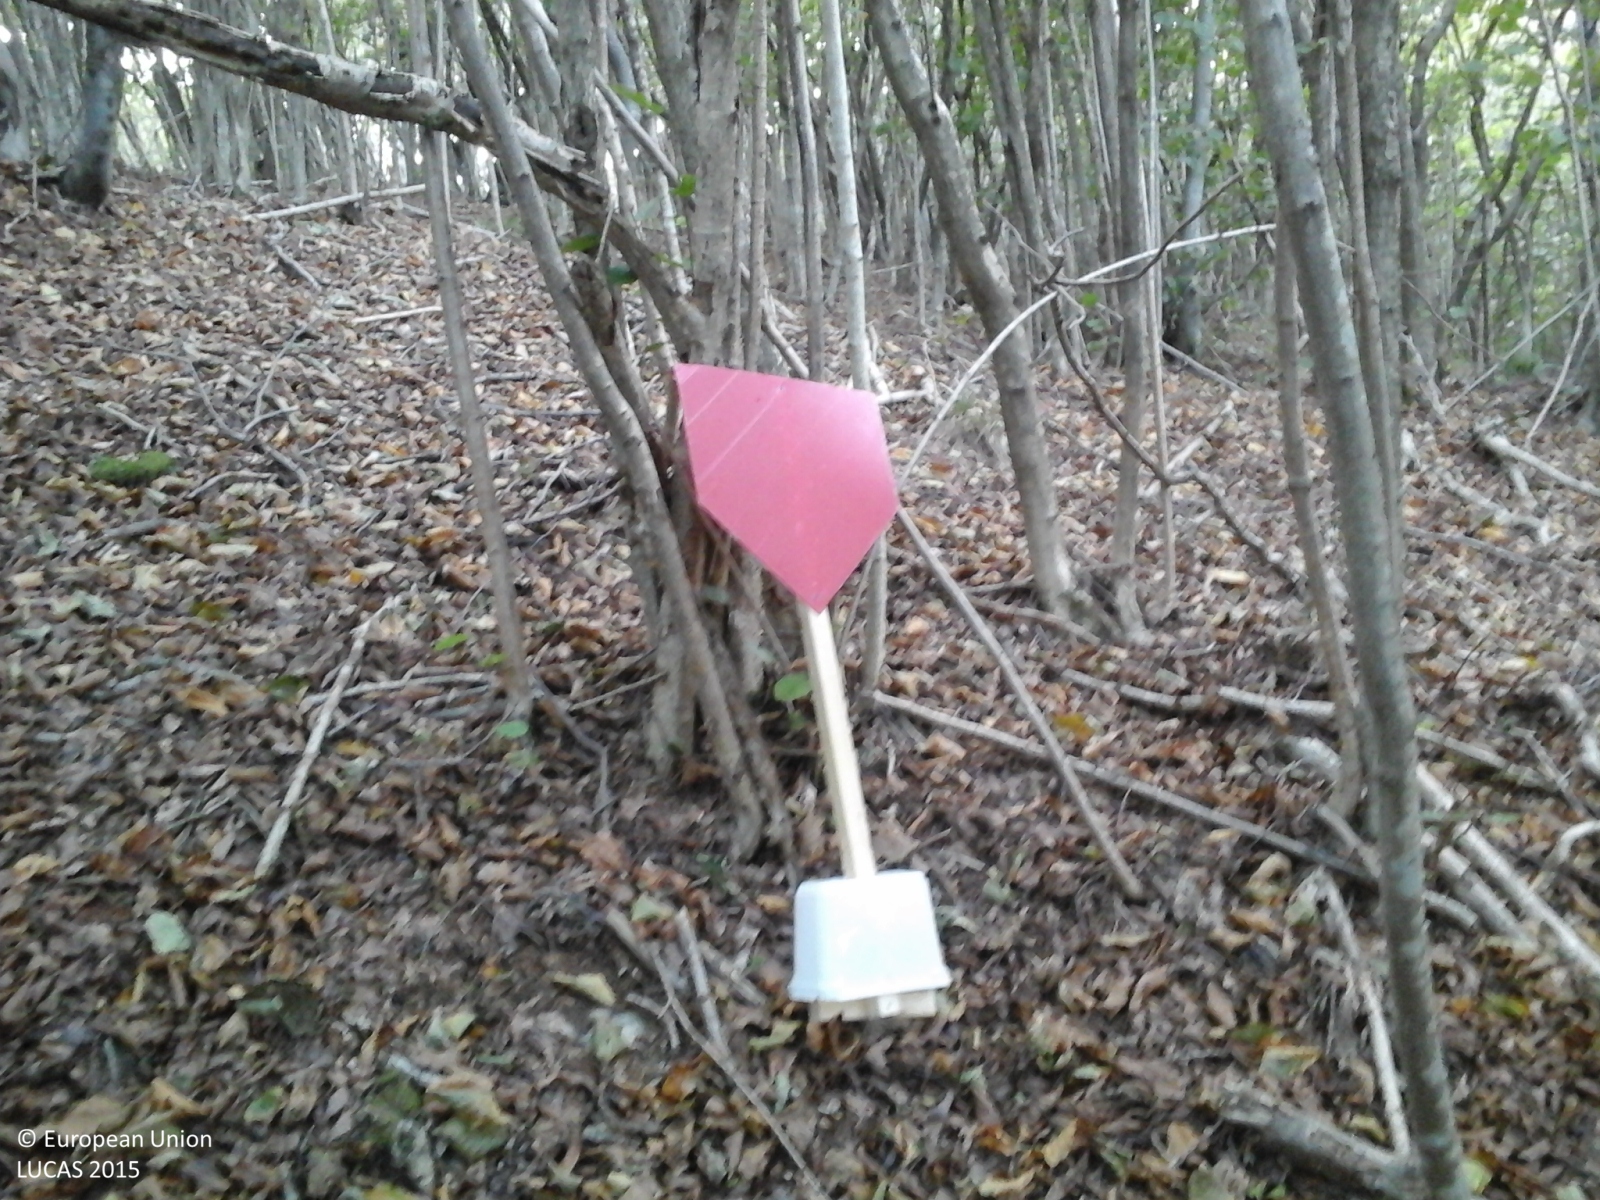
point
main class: Woodland
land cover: Broadleaved woodland
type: thermophilous deciduous forest
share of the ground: > 75 %
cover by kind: broadleaved forest trees 100 %
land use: Semi-natural and natural areas not in use
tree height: > 5 m
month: September
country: IT
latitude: 44.2454
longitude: 8.2383
